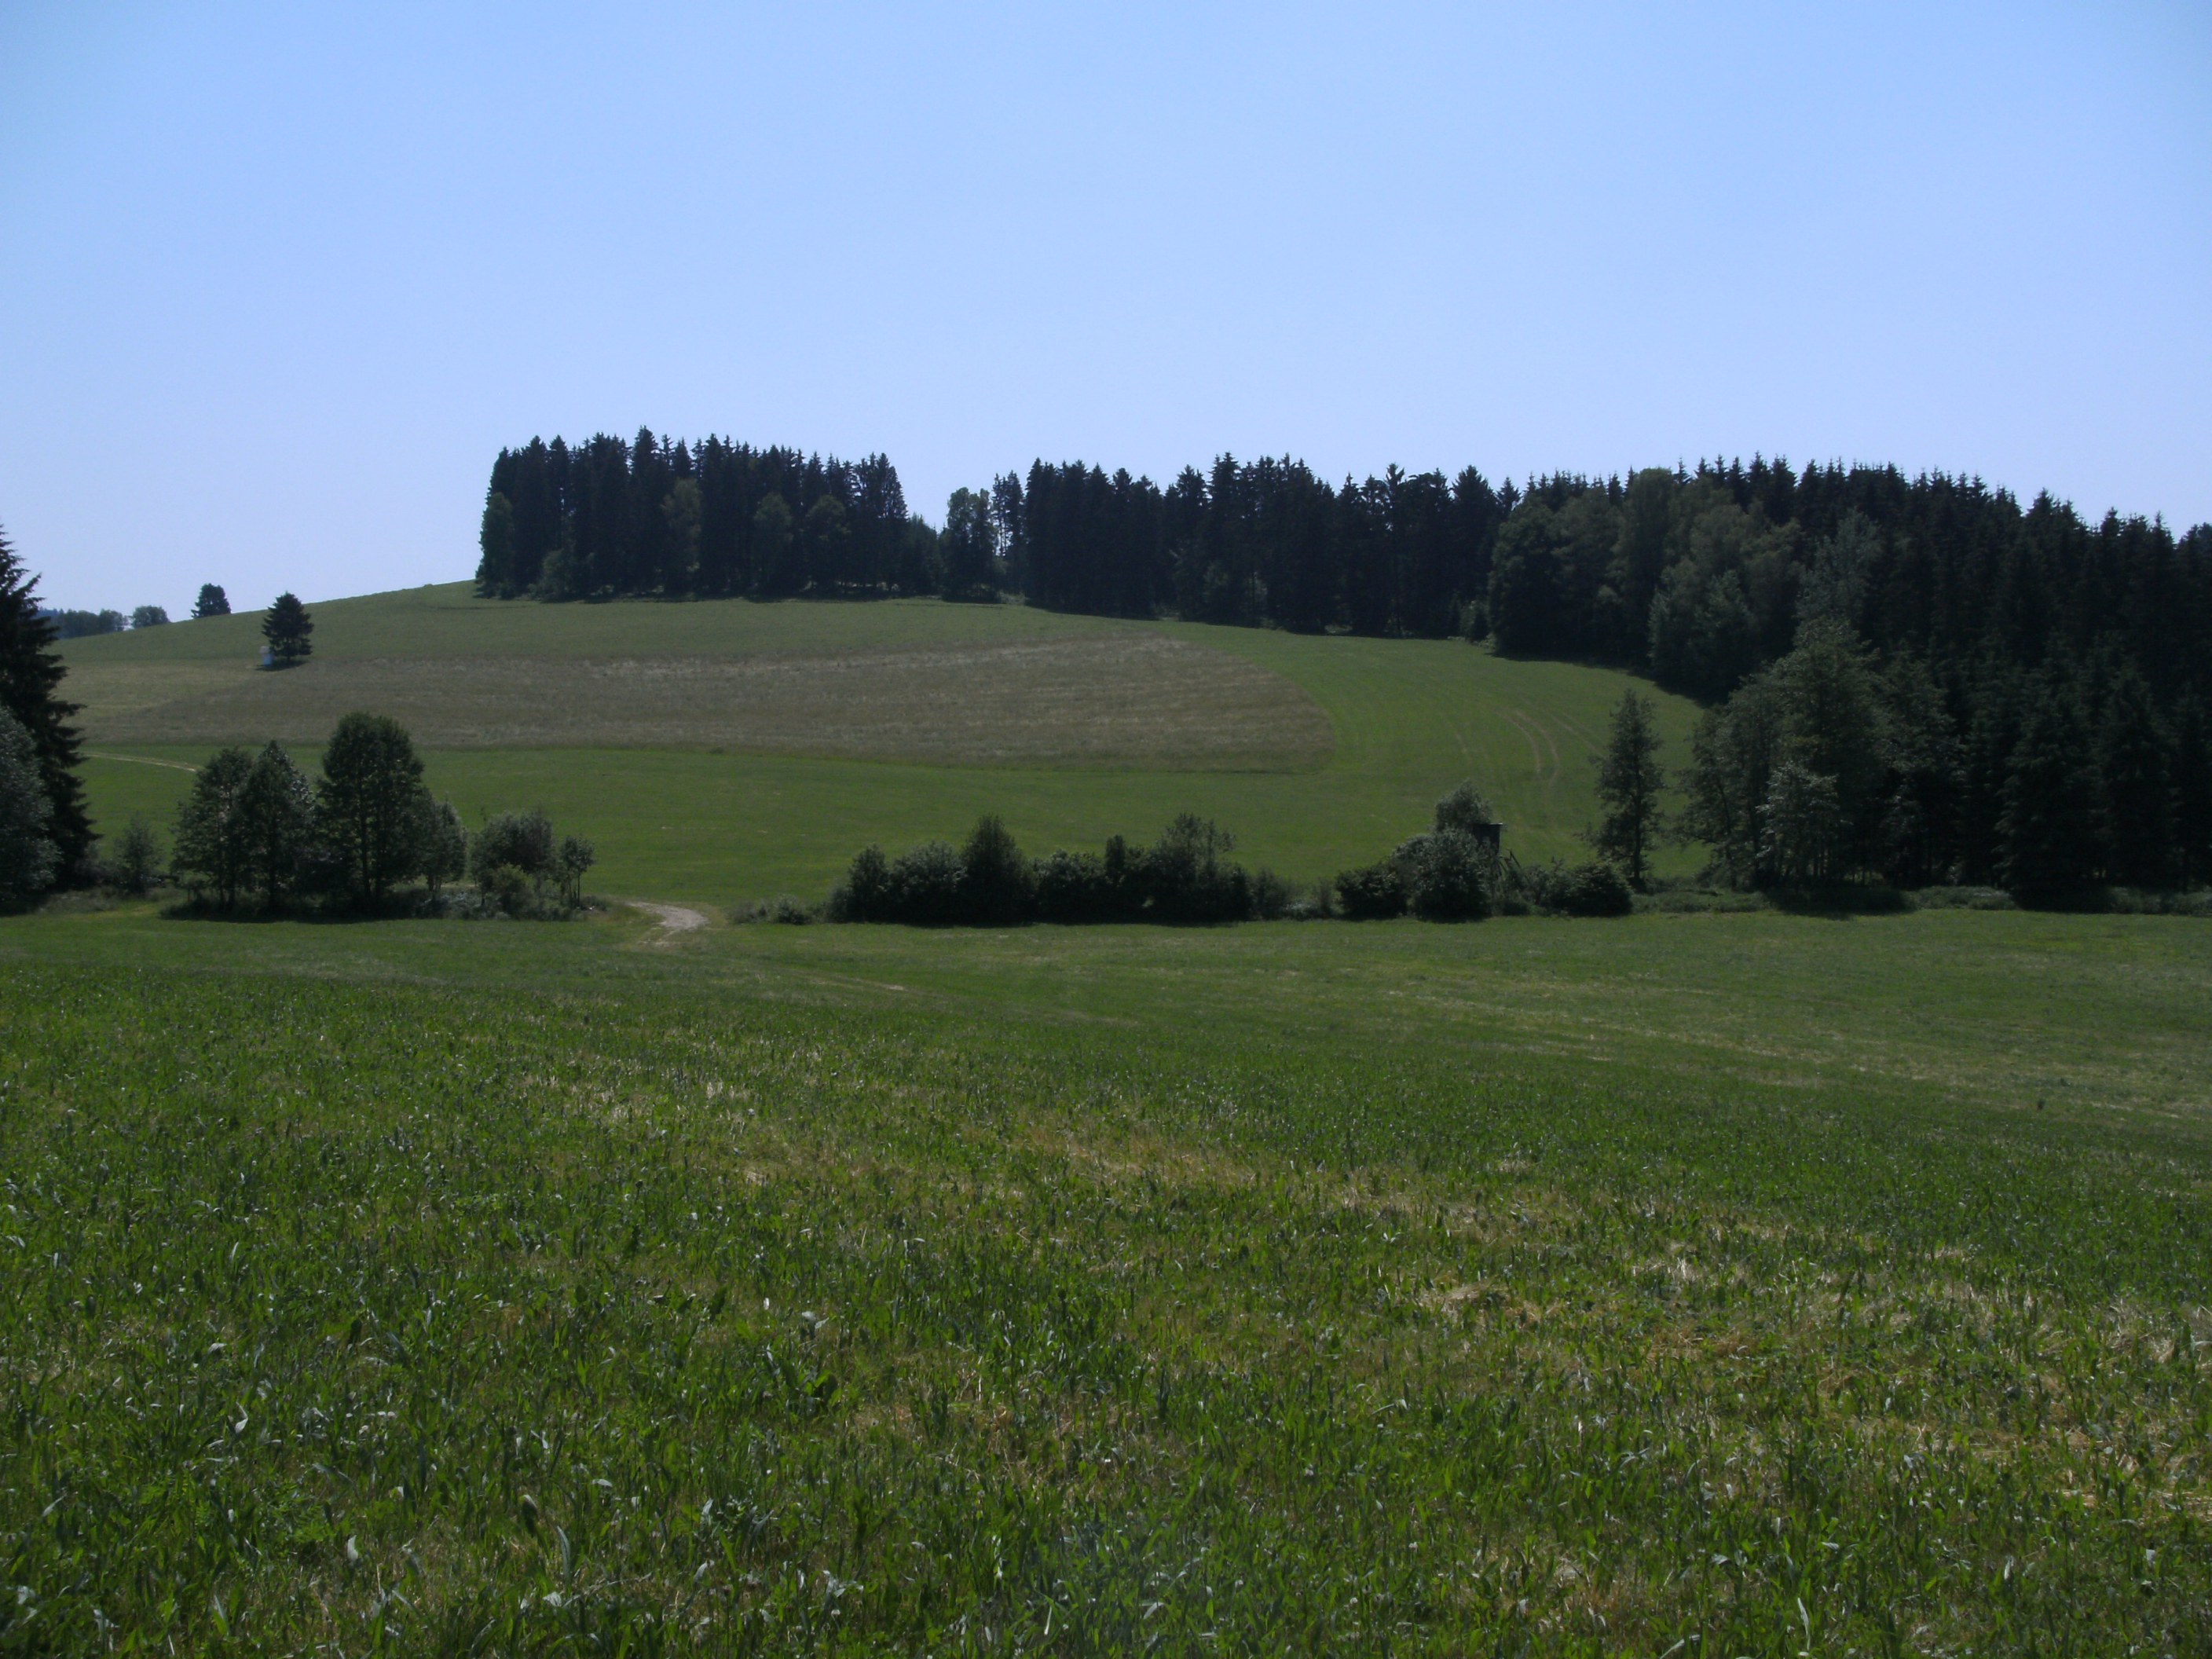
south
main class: Grassland
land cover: Grassland without tree/shrub cover
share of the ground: > 75 %
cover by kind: herbaceous plants 100 %
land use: Agriculture (excluding fallow land and kitchen gardens)
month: June
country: AT
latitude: 48.4686
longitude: 14.1795
